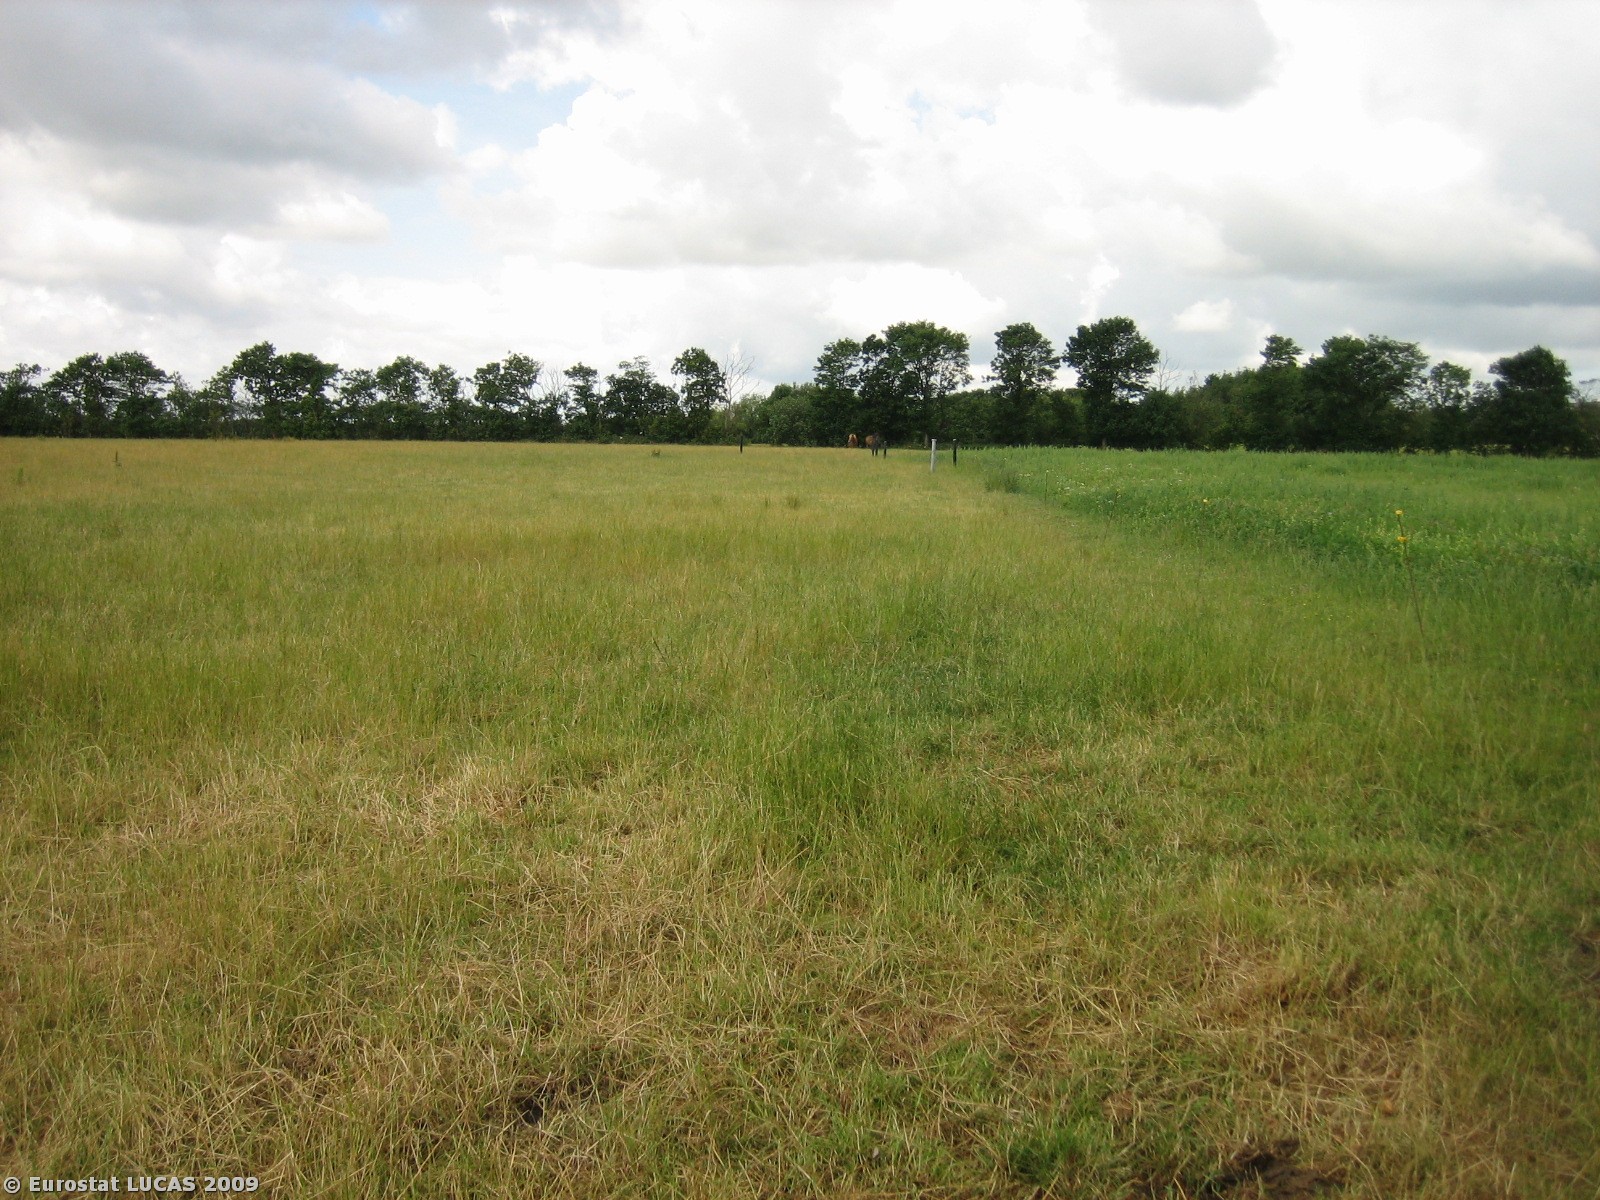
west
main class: Grassland
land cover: Grassland without tree/shrub cover
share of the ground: > 75 %
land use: Agriculture (excluding fallow land and kitchen gardens)
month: July
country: DK
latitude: 55.5680
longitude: 8.5265
